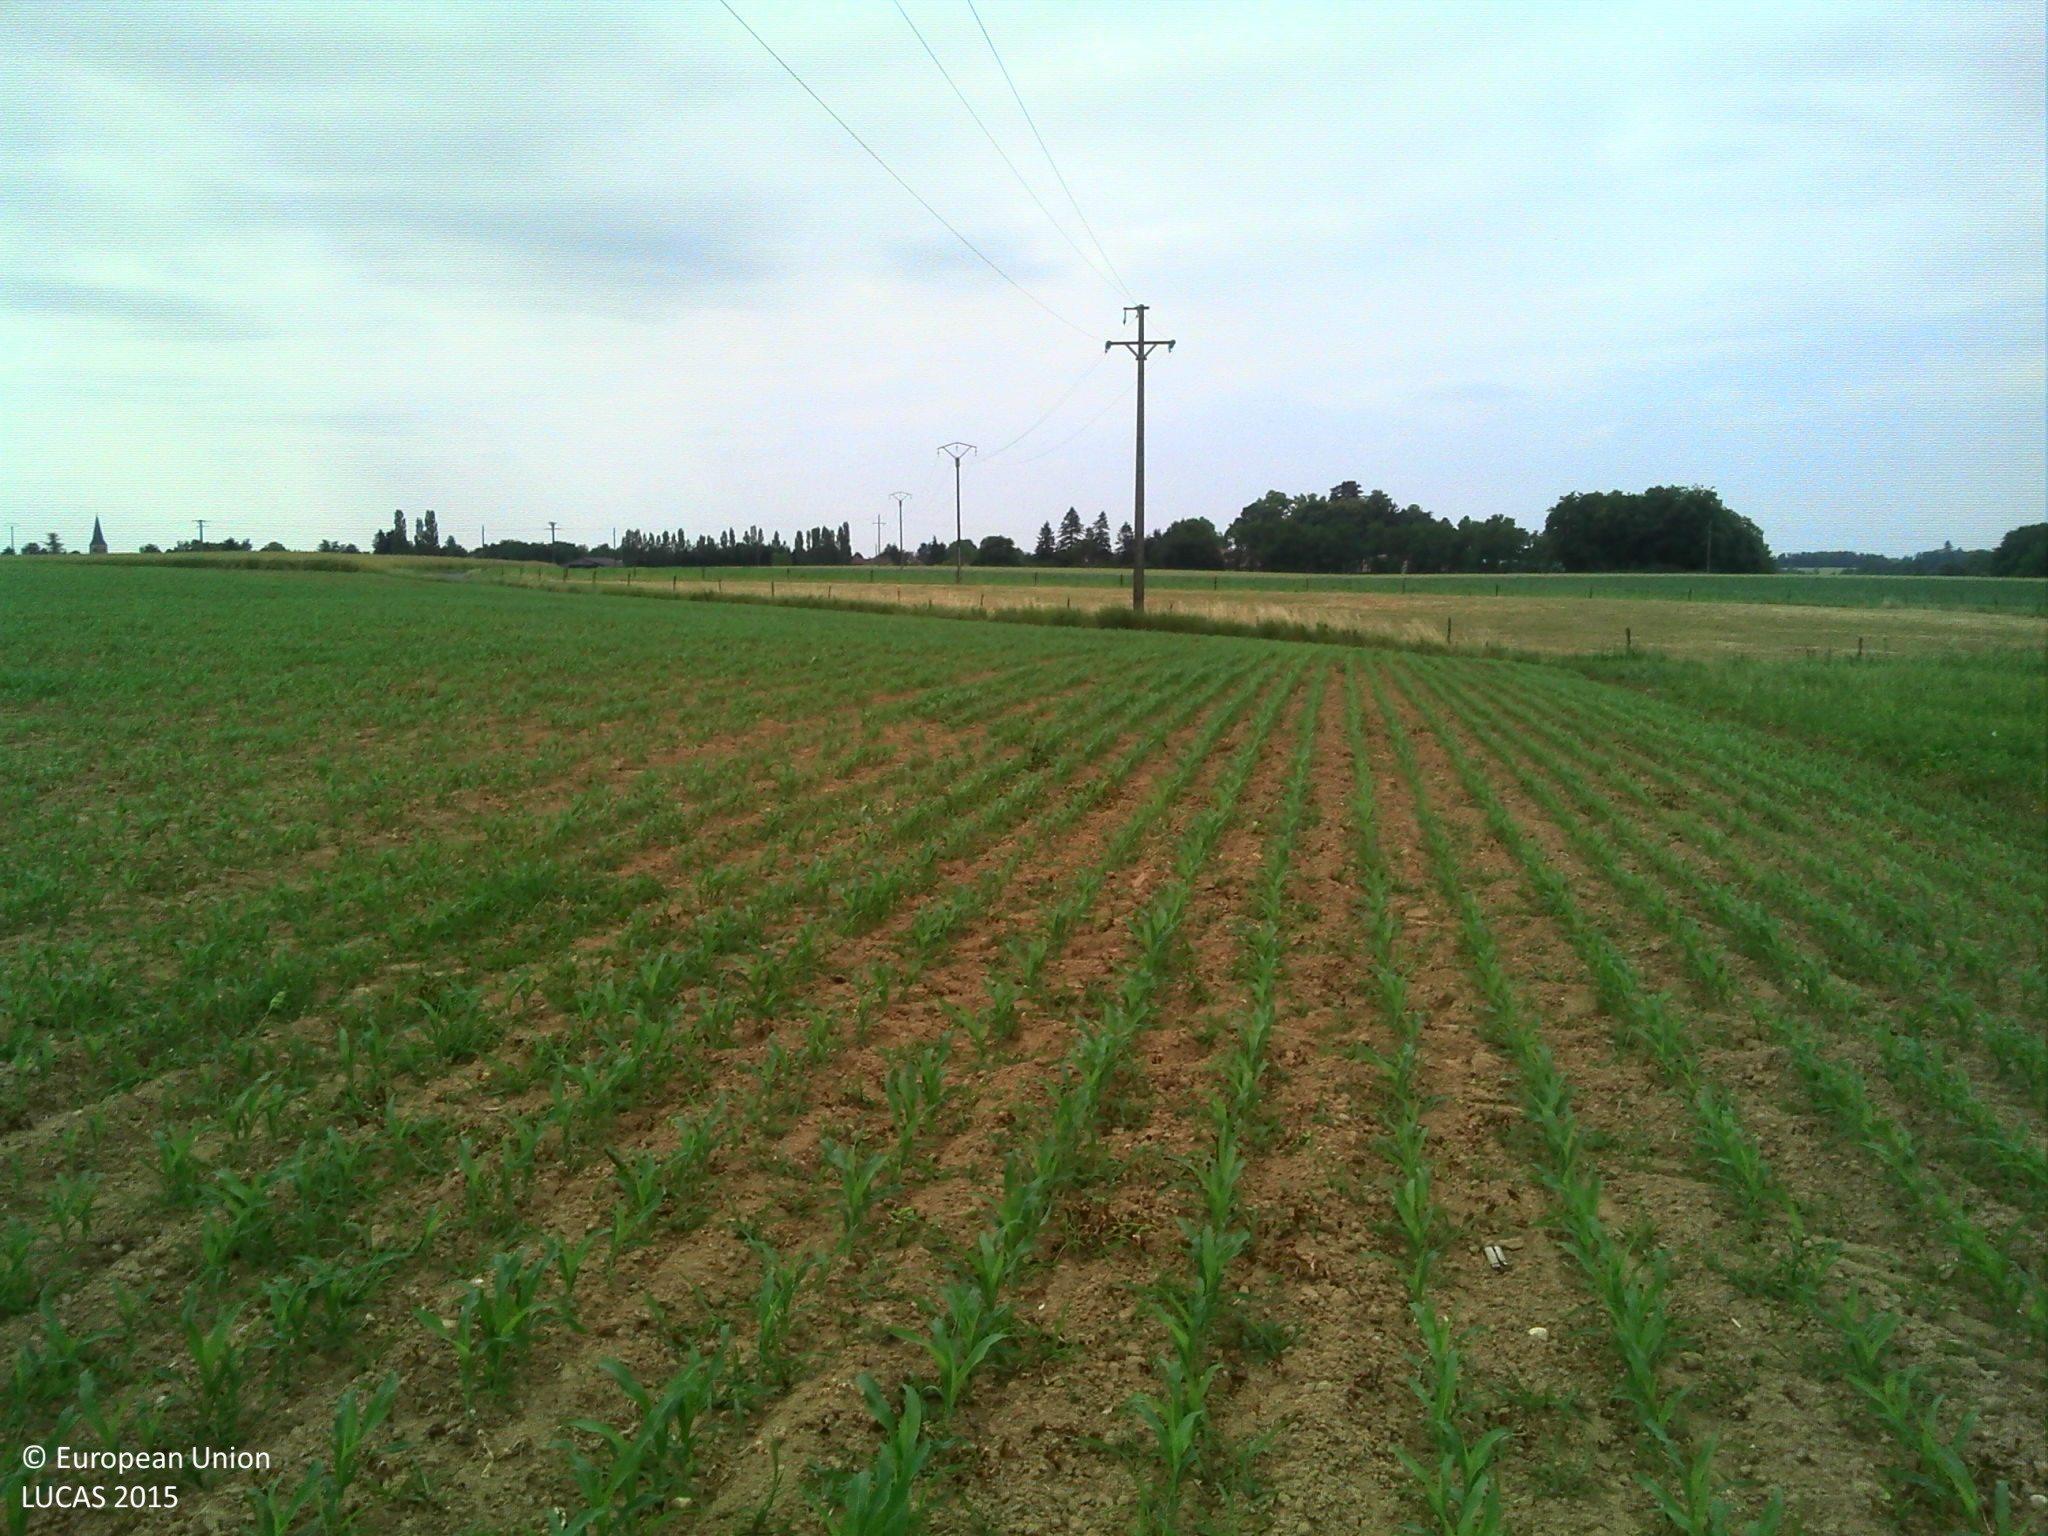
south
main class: Cropland
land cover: Maize
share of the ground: 25 - 50 %
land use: Agriculture (excluding fallow land and kitchen gardens)
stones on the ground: < 10 %
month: June
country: FR
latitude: 46.1351
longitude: 4.8121
